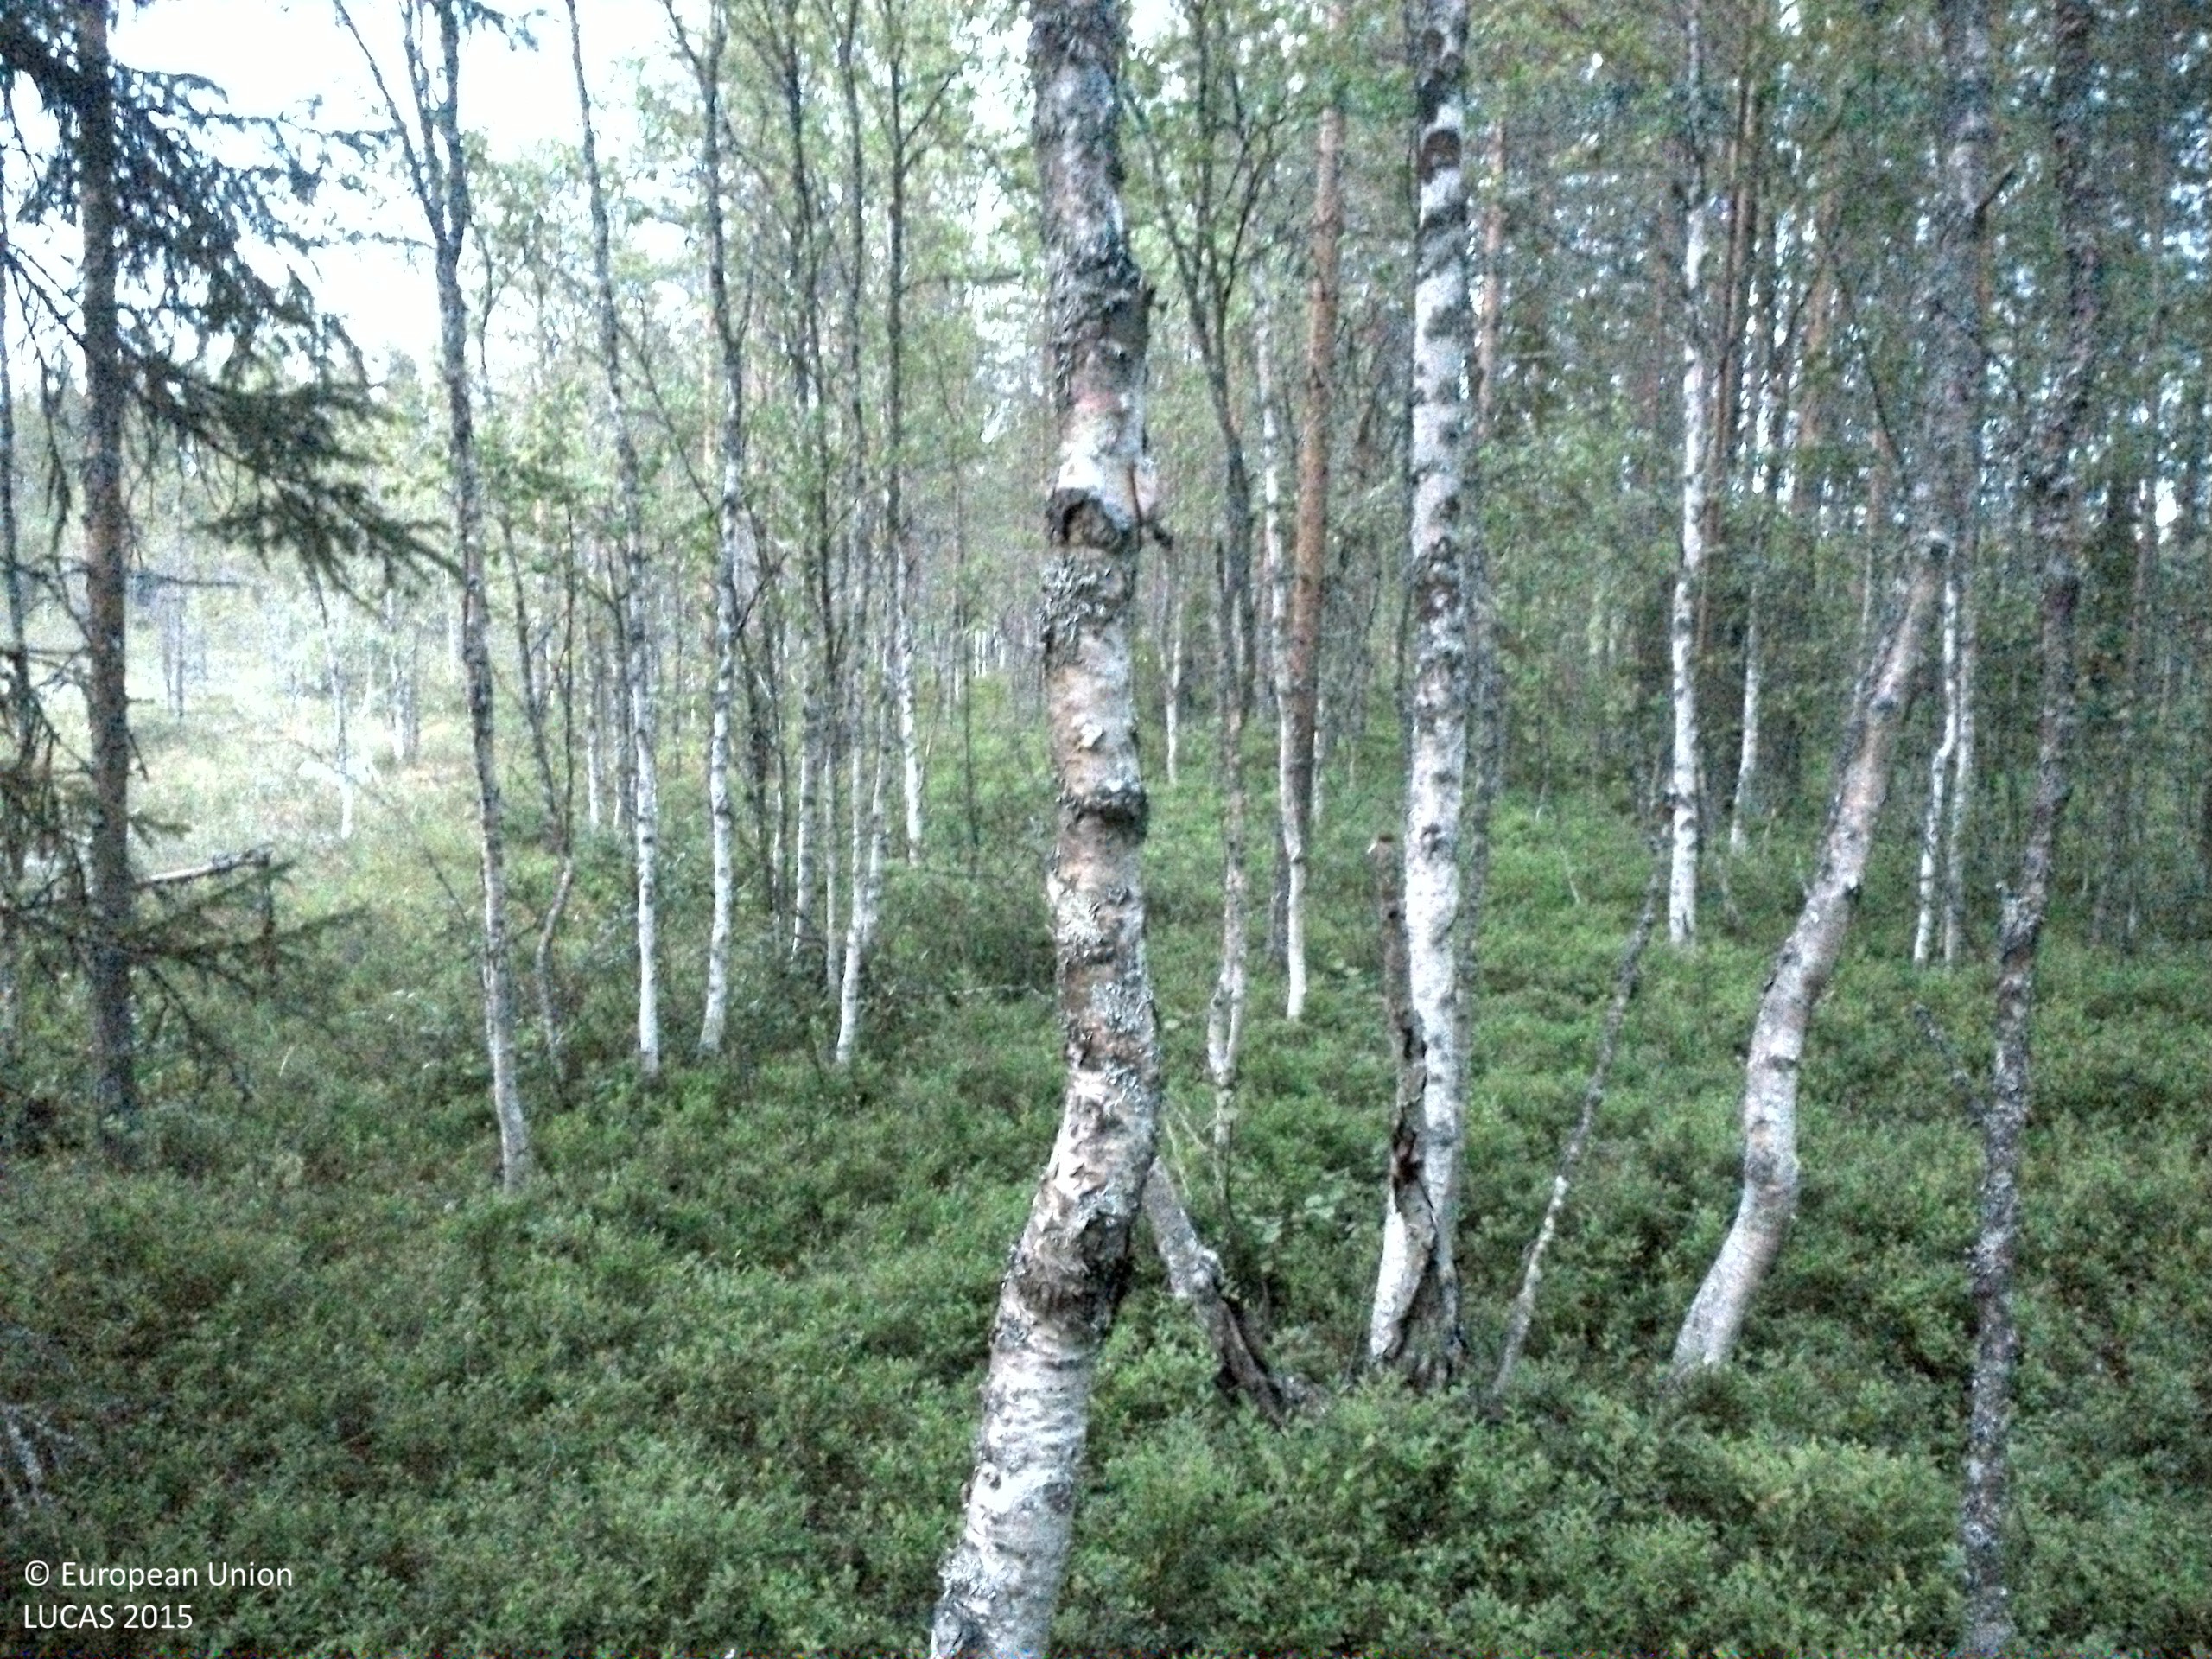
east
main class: Woodland
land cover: Pine dominated mixed woodland
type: boreal forest
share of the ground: 25 - 50 %
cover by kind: shrubs 45 %, coniferous forest trees 30 %, broadleaved forest trees 15 %, lichens and mosses 10 %
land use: Forestry
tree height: > 5 m
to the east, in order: Pine dominated mixed woodland; Pine dominated coniferous woodland; Broadleaved woodland; Pine dominated coniferous woodland
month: July
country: SE
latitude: 64.3526
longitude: 16.1194
